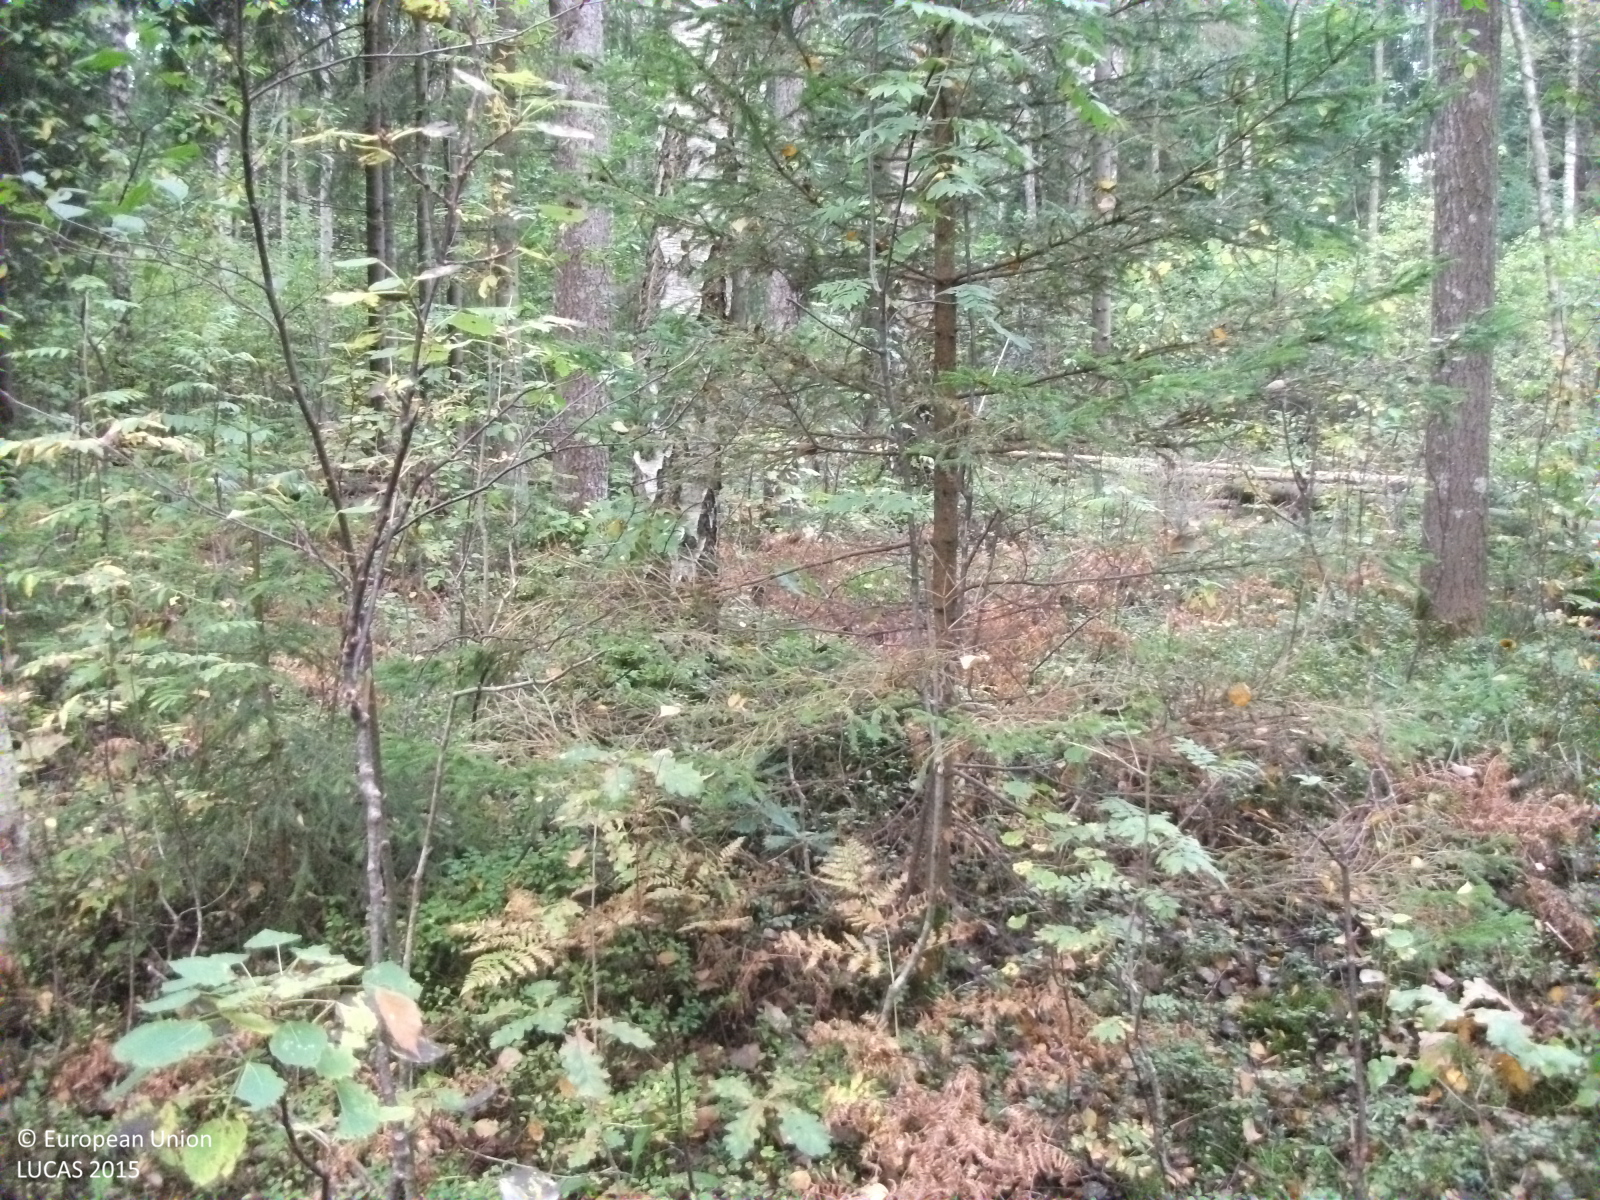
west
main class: Woodland
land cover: Spruce dominated mixed woodland
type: hemiboreal forest and nemoral coniferous forest and mixed broadleaved-coniferous forest
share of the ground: > 75 %
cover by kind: broadleaved forest trees 50 %, coniferous forest trees 35 %, herbaceous plants 10 %, shrubs 5 %
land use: Forestry
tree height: > 5 m
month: September
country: LV
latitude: 57.6948
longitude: 24.3982
